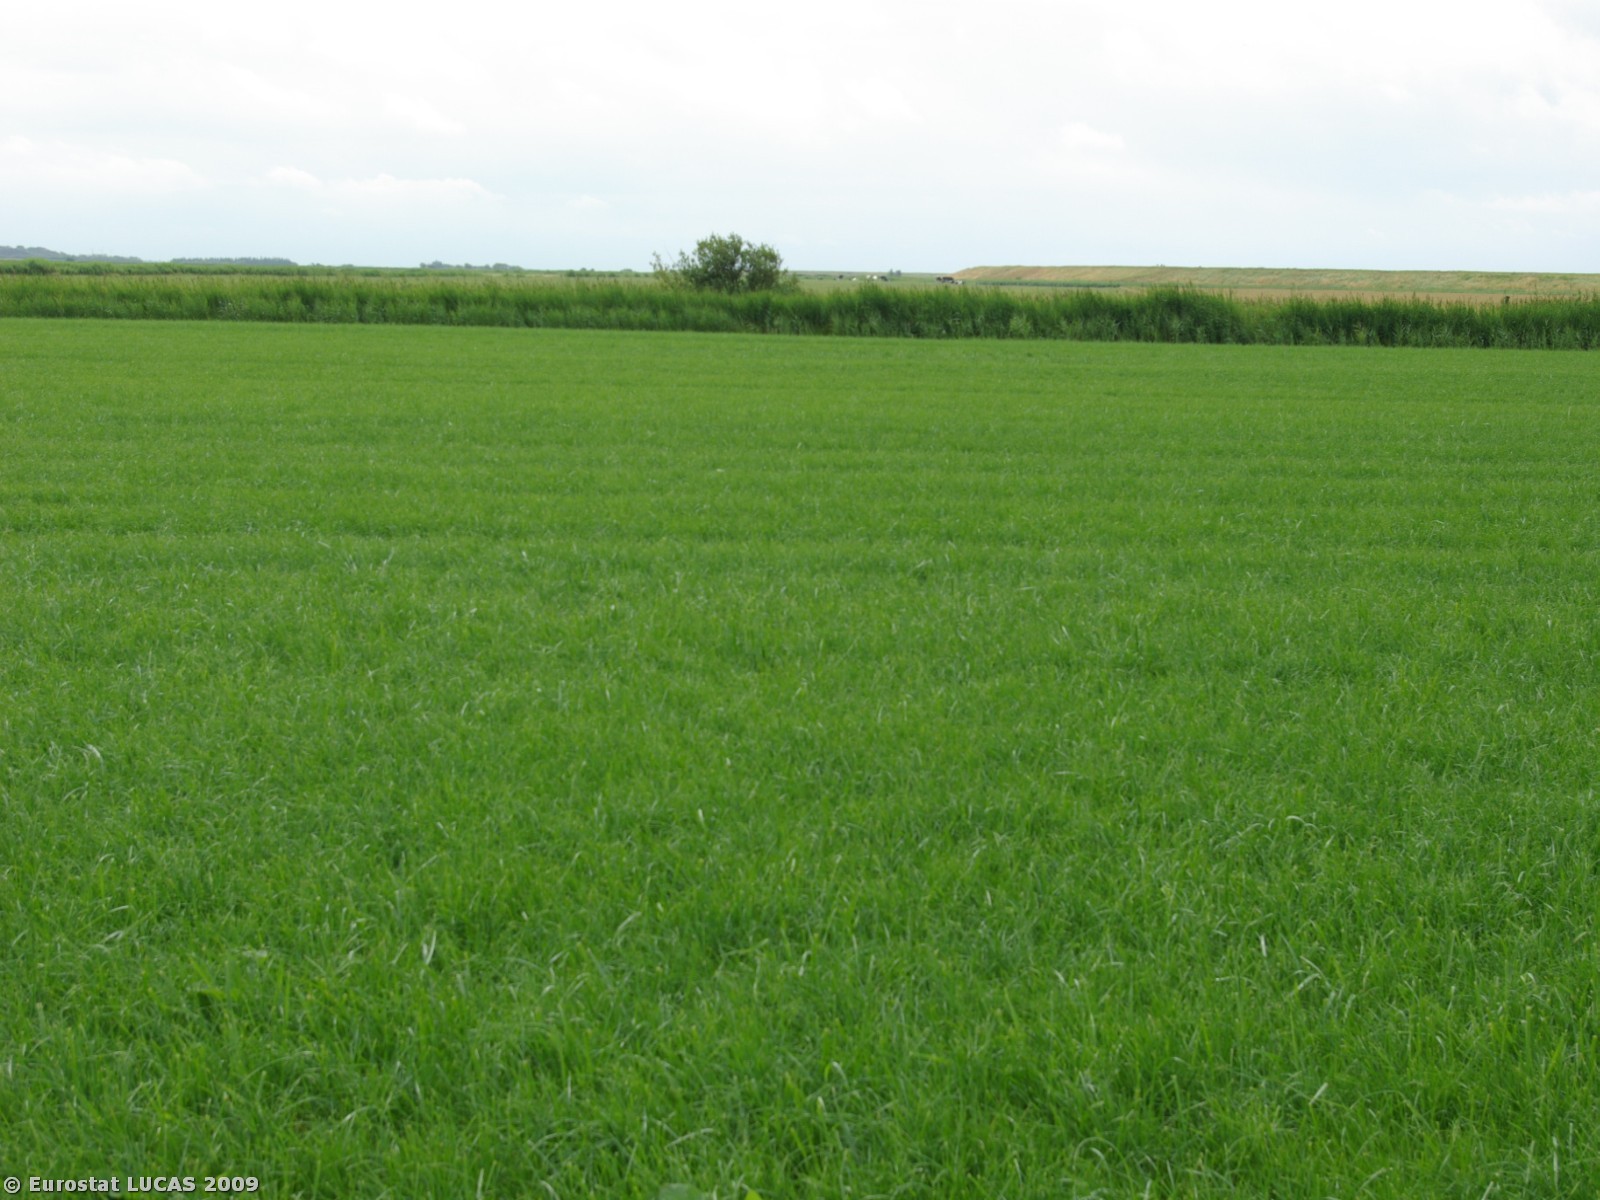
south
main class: Cropland
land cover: Temporary grasslands
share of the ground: > 75 %
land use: Agriculture (excluding fallow land and kitchen gardens)
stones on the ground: < 10 %
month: July
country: DK
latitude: 55.2819
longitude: 8.6629
